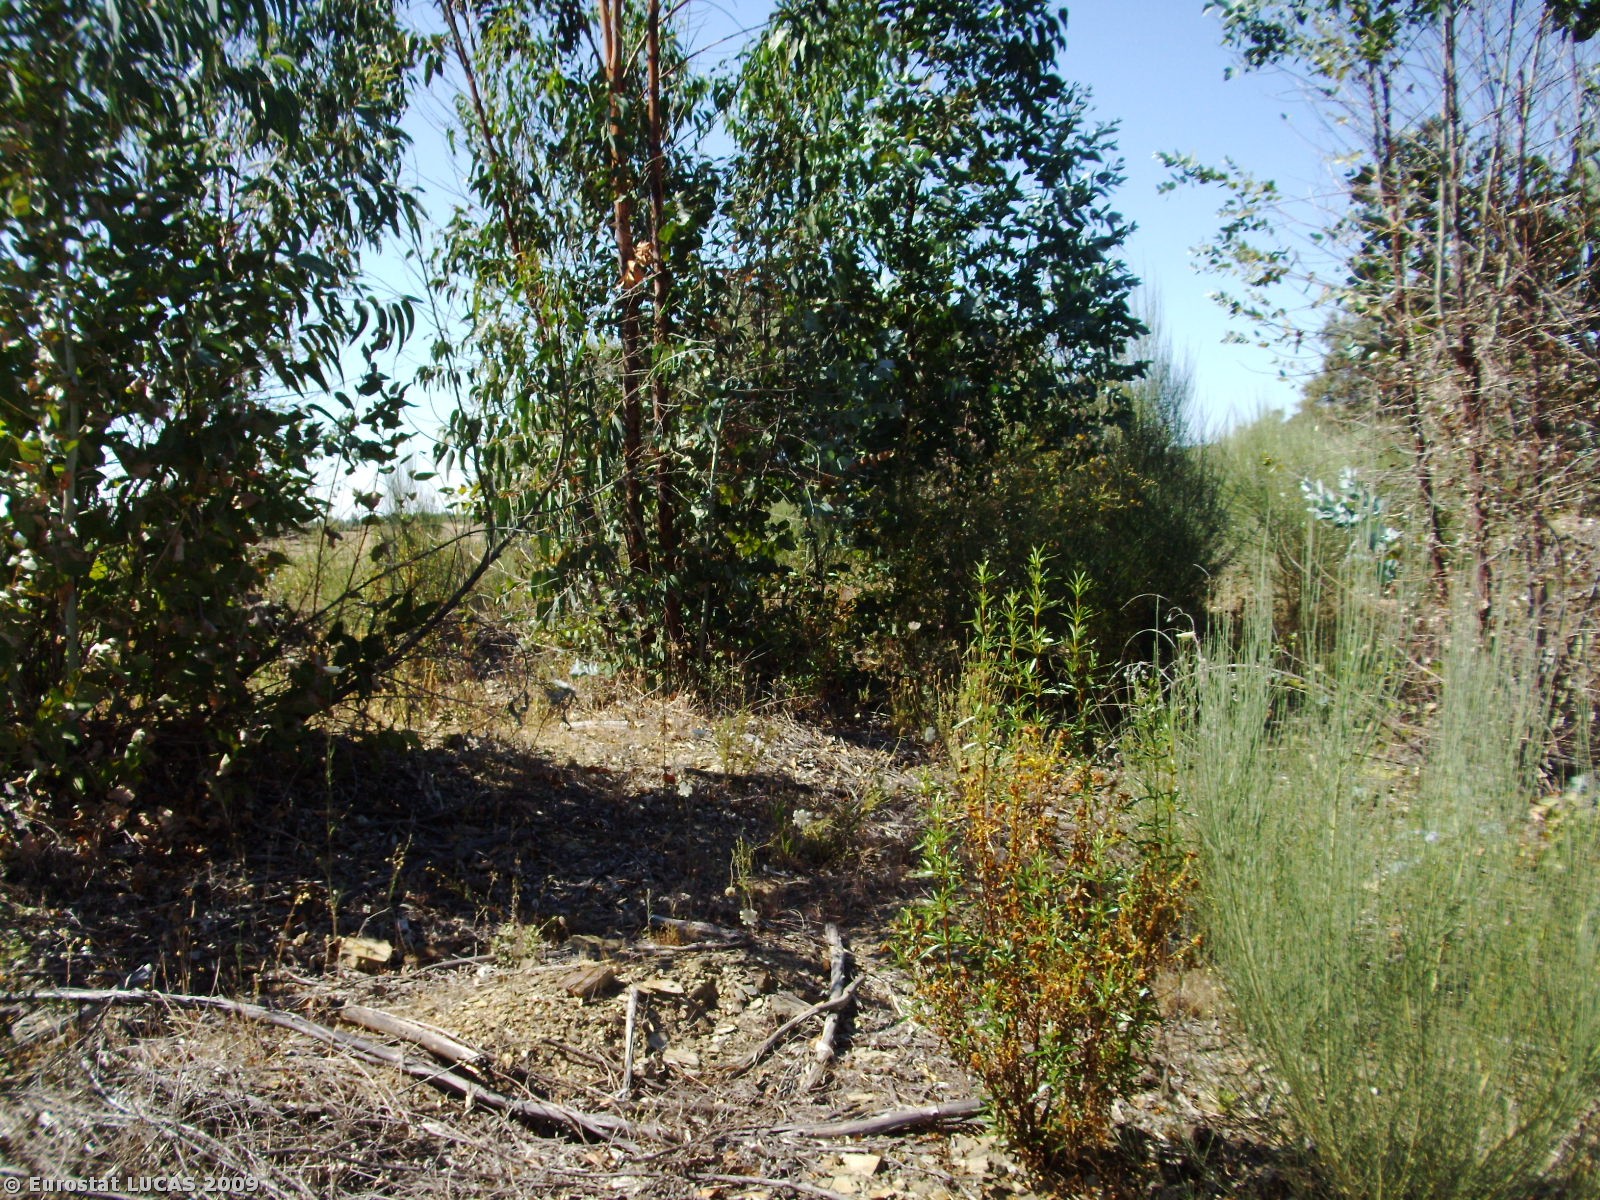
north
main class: Woodland
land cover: Broadleaved woodland
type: plantations and self-sown exotic forest
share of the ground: > 75 %
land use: Forestry
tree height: > 5 m
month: June
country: PT
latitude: 40.0416
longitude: -7.2198
